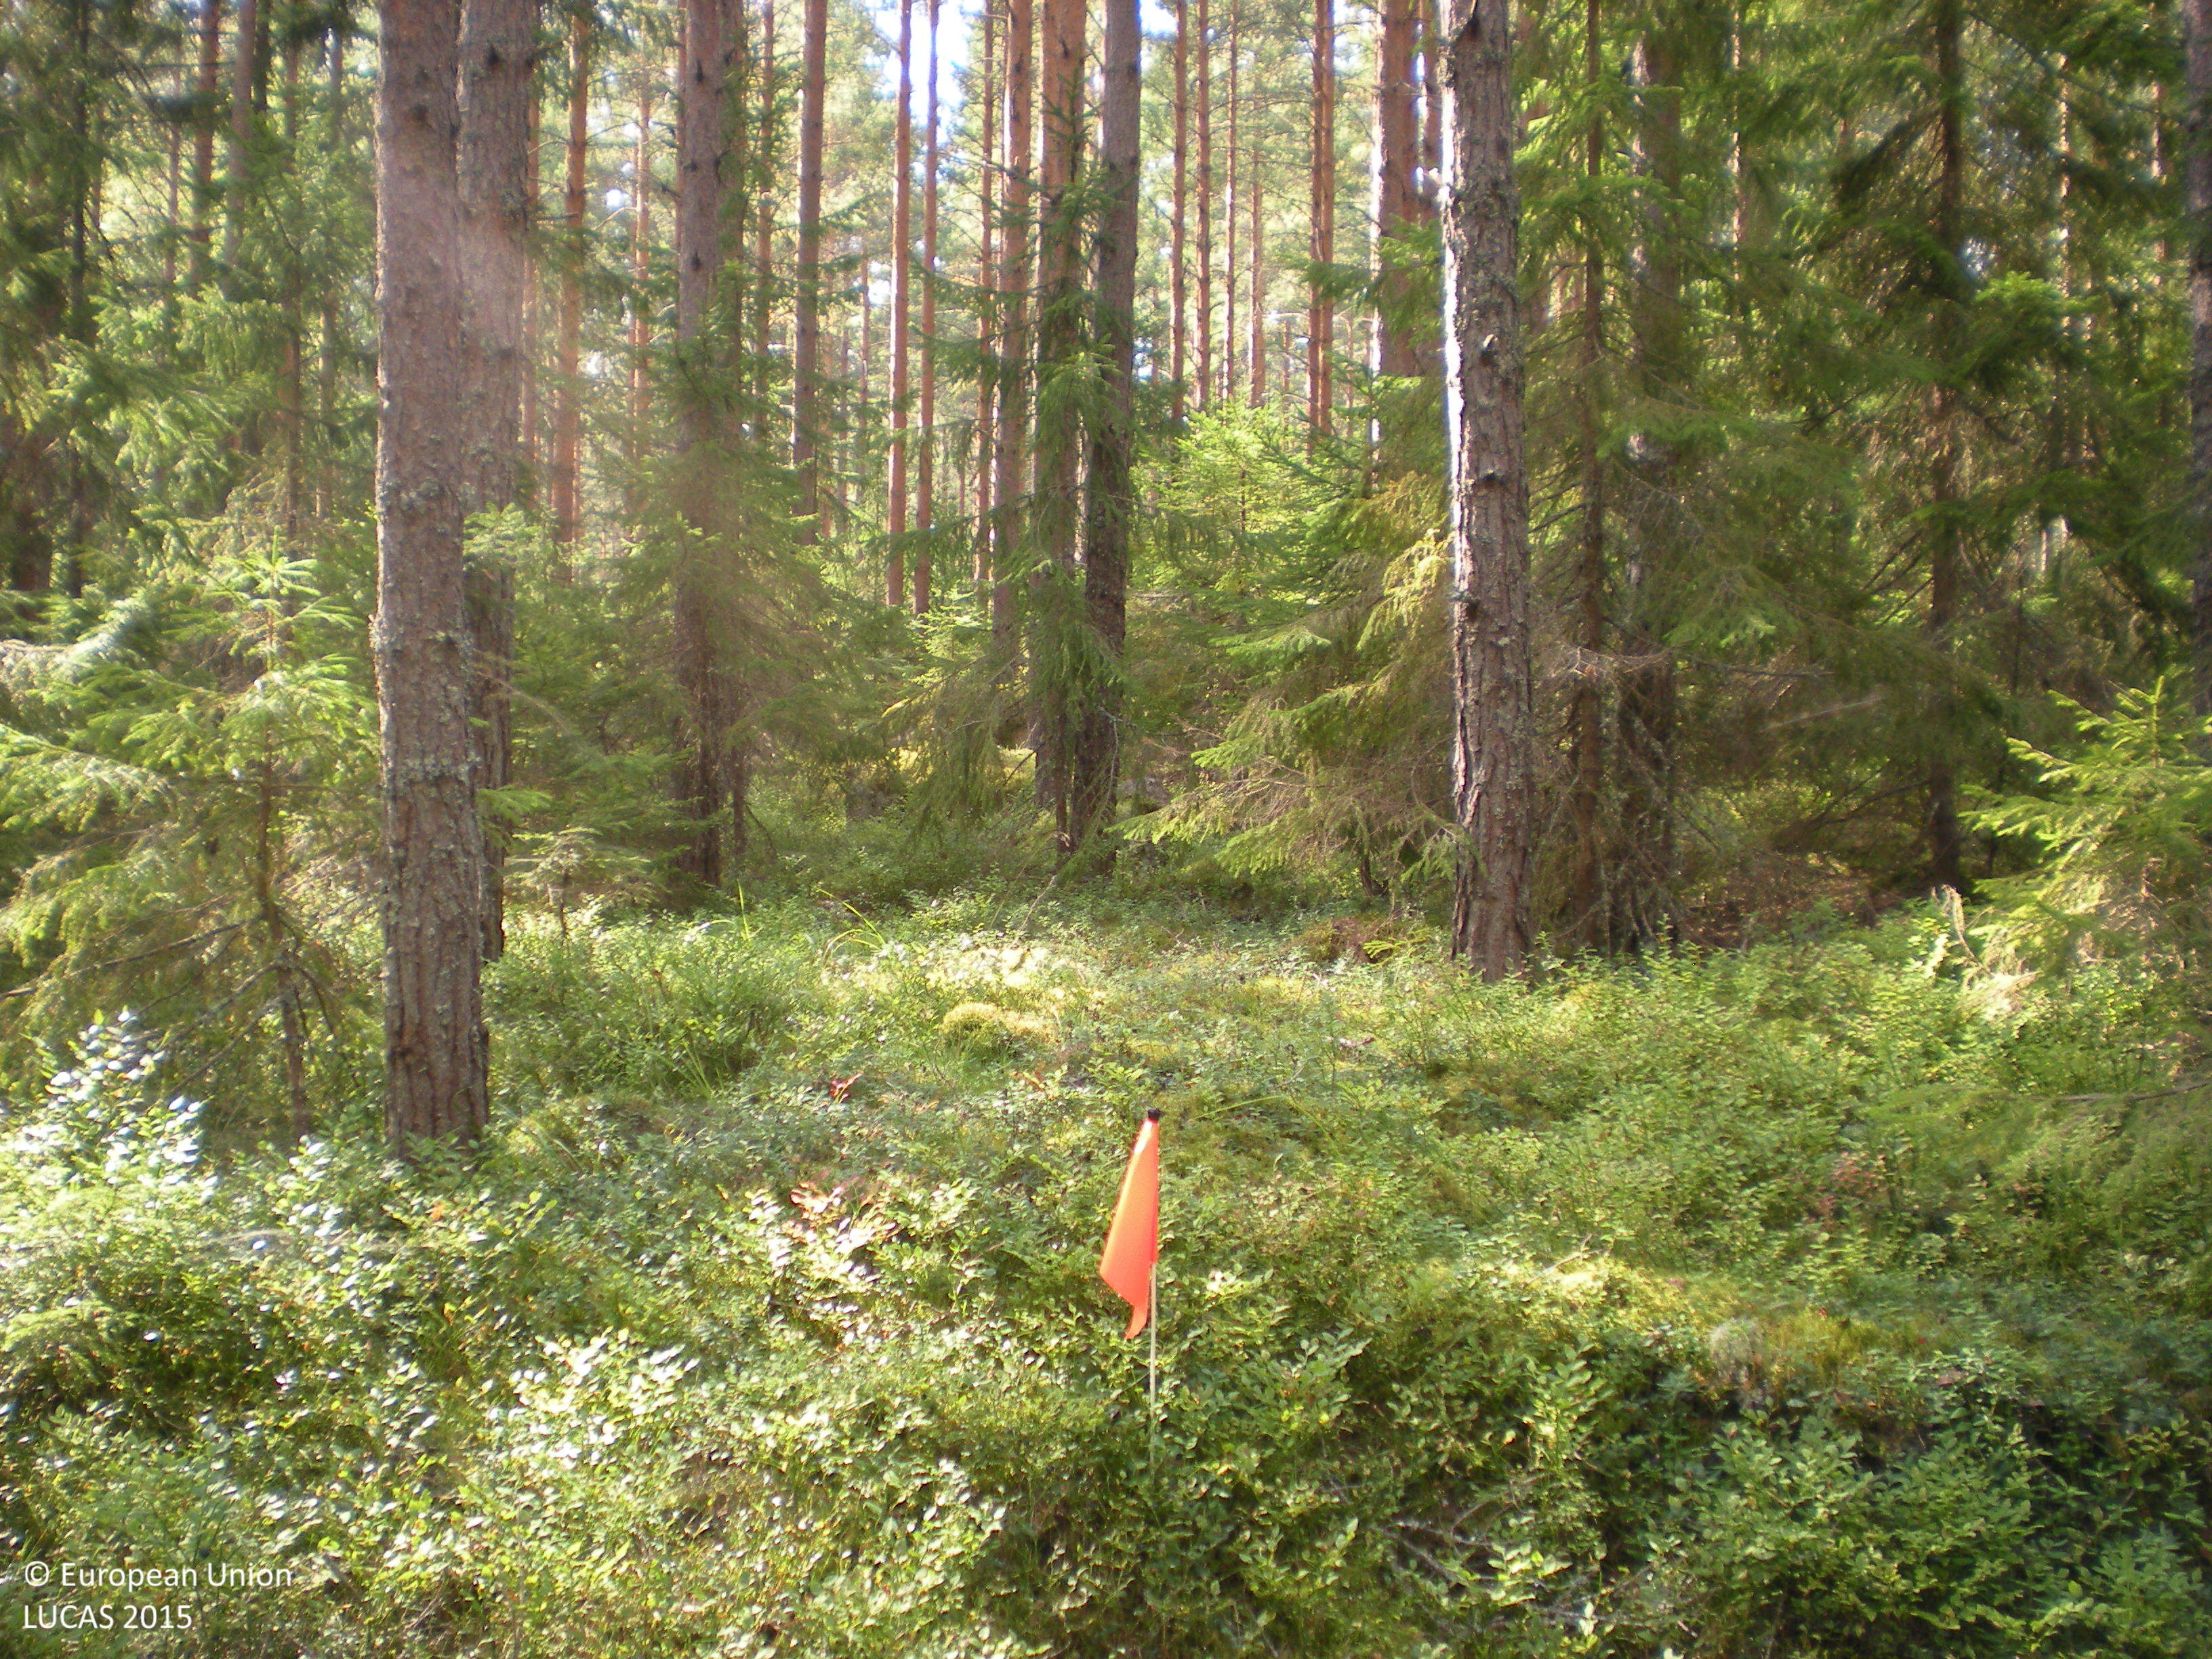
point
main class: Woodland
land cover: Pine dominated coniferous woodland
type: boreal forest
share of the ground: 50 - 75 %
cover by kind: coniferous forest trees 70 %, shrubs 25 %, lichens and mosses 5 %
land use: Forestry
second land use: Amenities, museums, leisure
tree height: > 5 m
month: August
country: SE
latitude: 60.4164
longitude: 17.1266
